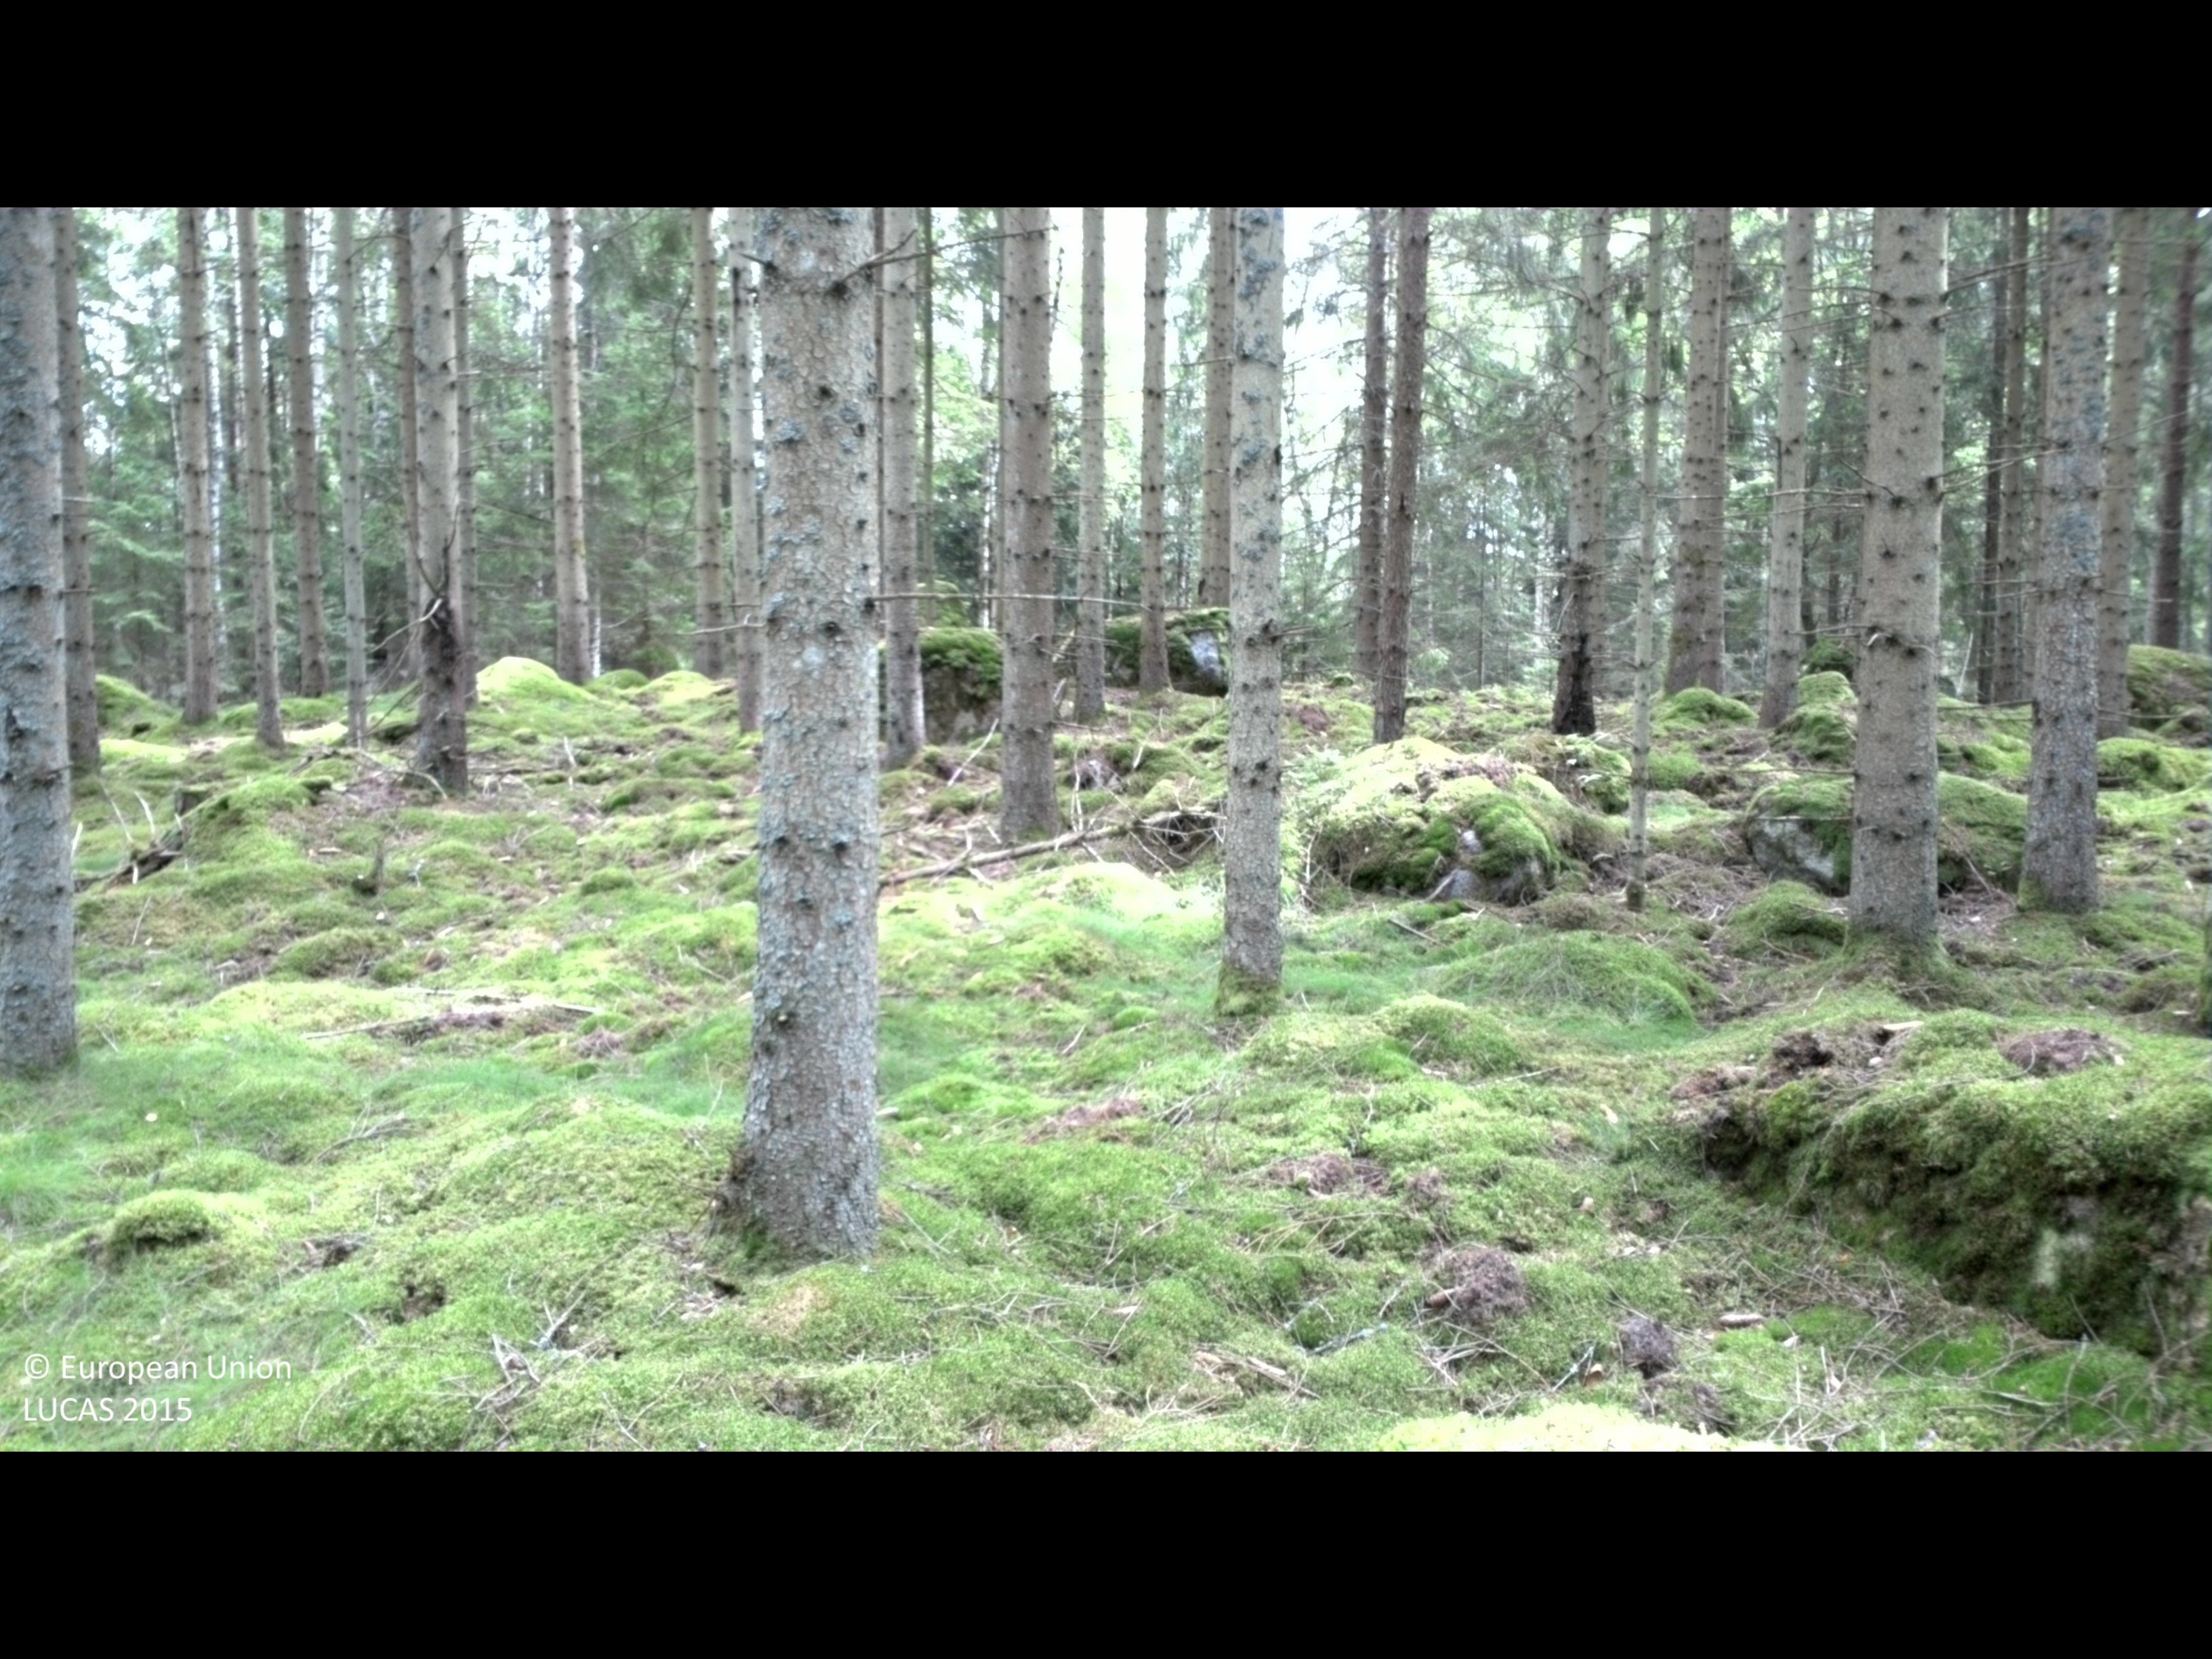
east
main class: Woodland
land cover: Spruce dominated coniferous woodland
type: boreal forest
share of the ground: > 75 %
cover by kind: coniferous forest trees 75 %, lichens and mosses 25 %
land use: Forestry
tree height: > 5 m
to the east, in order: Spruce dominated coniferous woodland; Spontaneously vegetated surfaces; Ditches and canals; Spontaneously vegetated surfaces; Ditches and canals; Spruce dominated coniferous woodland
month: August
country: SE
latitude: 56.4312
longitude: 14.5543
